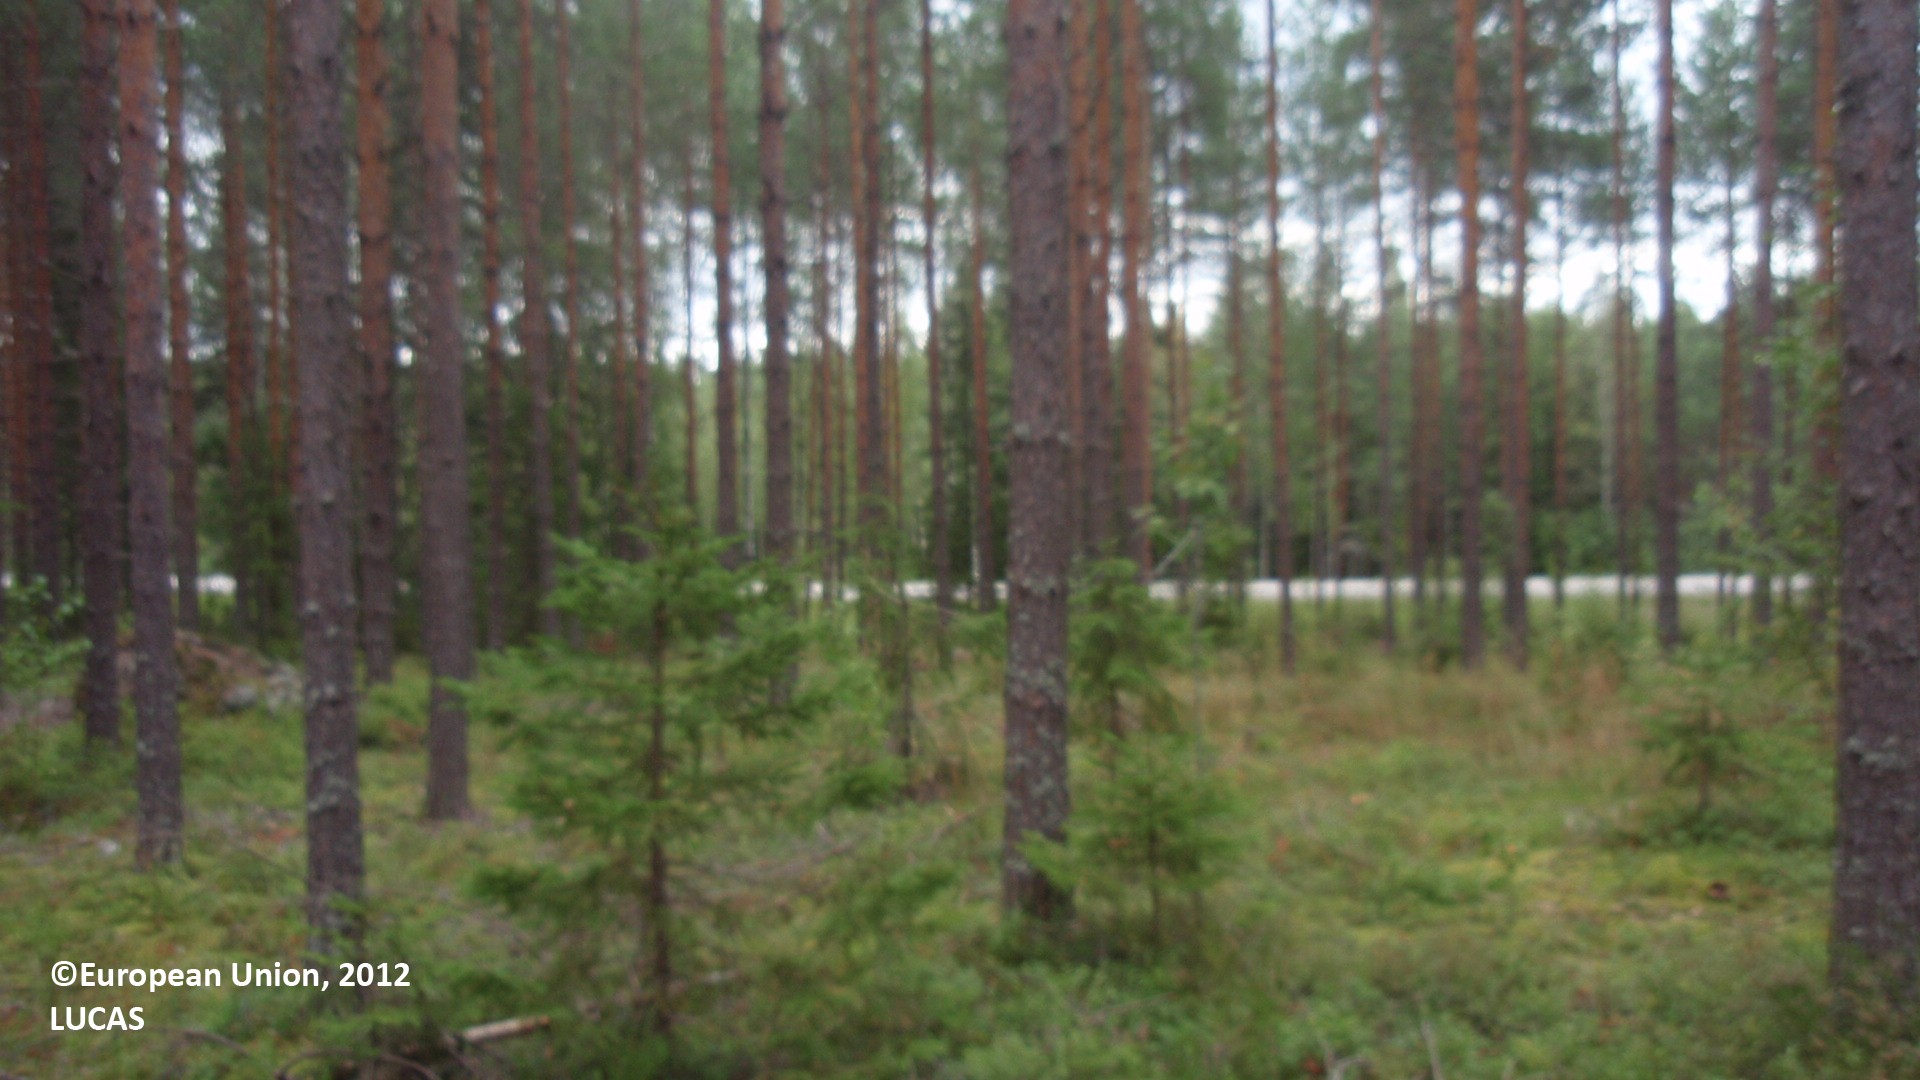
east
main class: Woodland
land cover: Pine dominated coniferous woodland
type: boreal forest
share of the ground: 50 - 75 %
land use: Forestry
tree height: > 5 m
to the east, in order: Pine dominated coniferous woodland; Grassland with sparse tree/shrub cover; Paved roads, cycling and walking lanes; Grassland with sparse tree/shrub cover; Ditches and canals; Pine dominated mixed woodland; Spruce dominated coniferous woodland
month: August
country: FI
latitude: 60.7769
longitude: 27.3480
